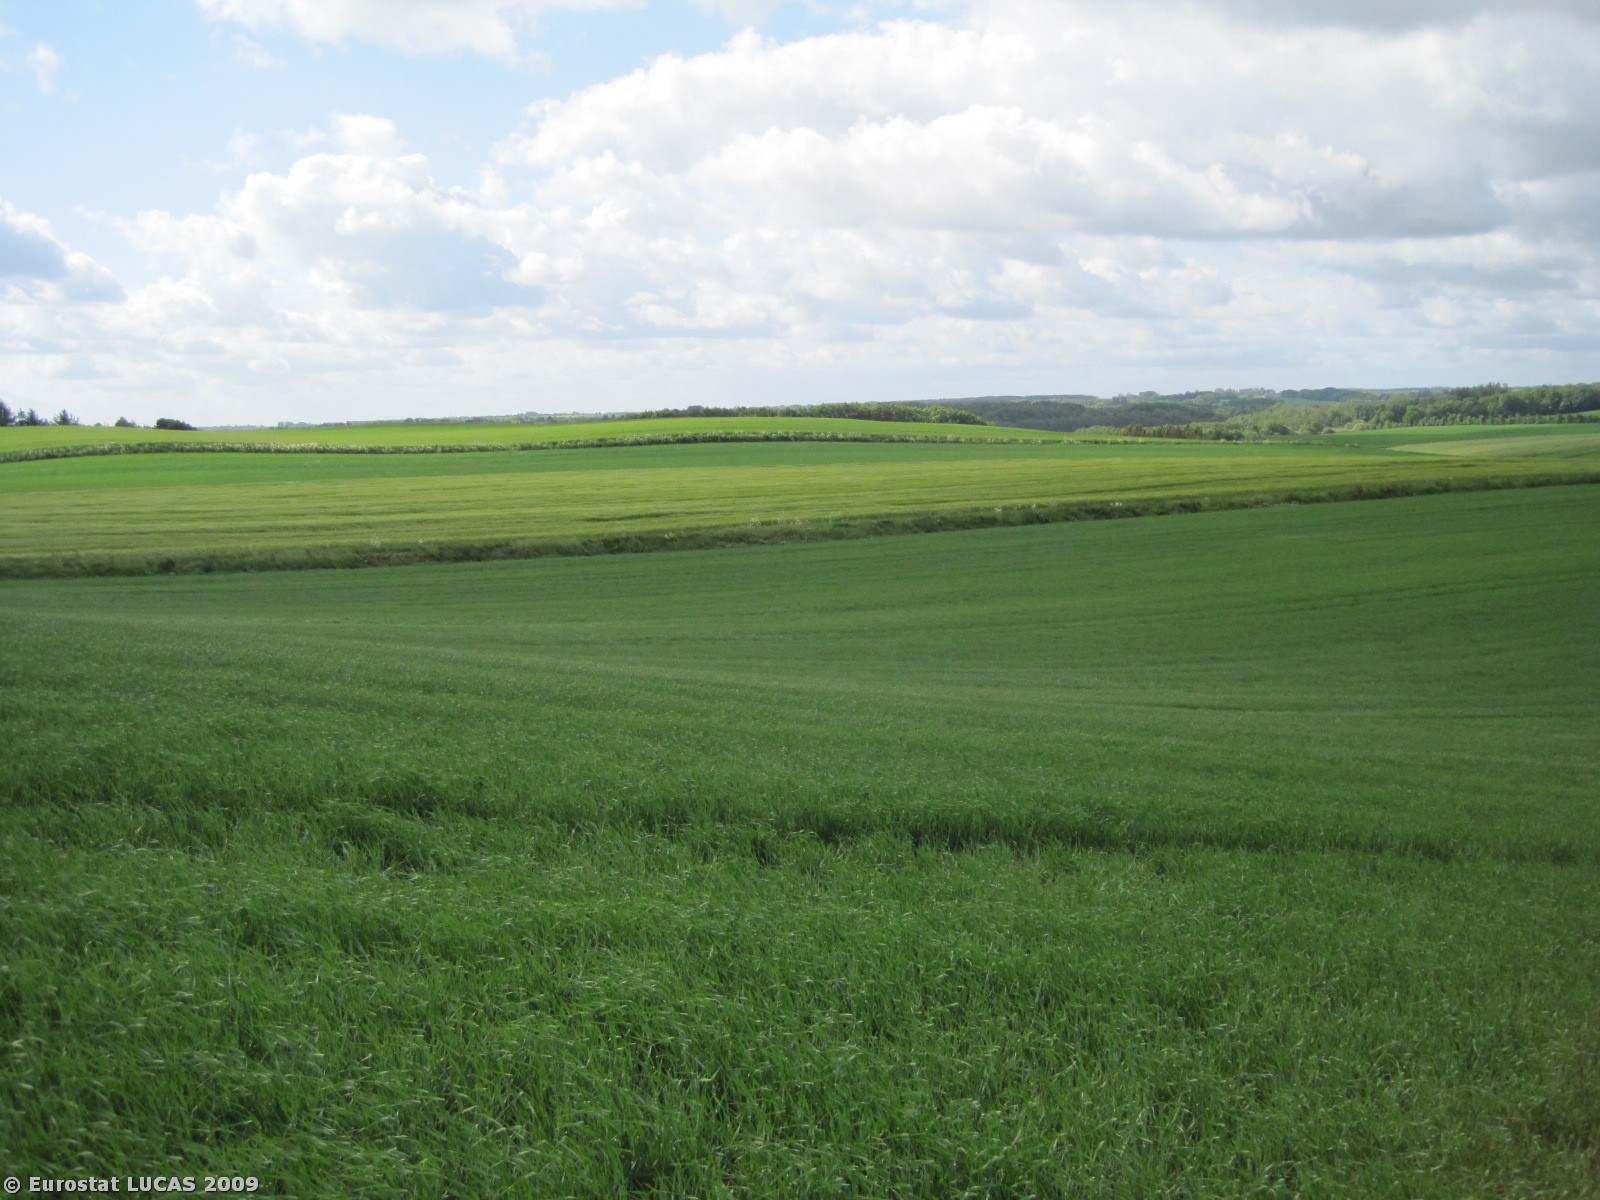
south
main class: Cropland
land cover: Barley
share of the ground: > 75 %
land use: Agriculture (excluding fallow land and kitchen gardens)
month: May
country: DK
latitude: 56.5649
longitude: 9.6912
